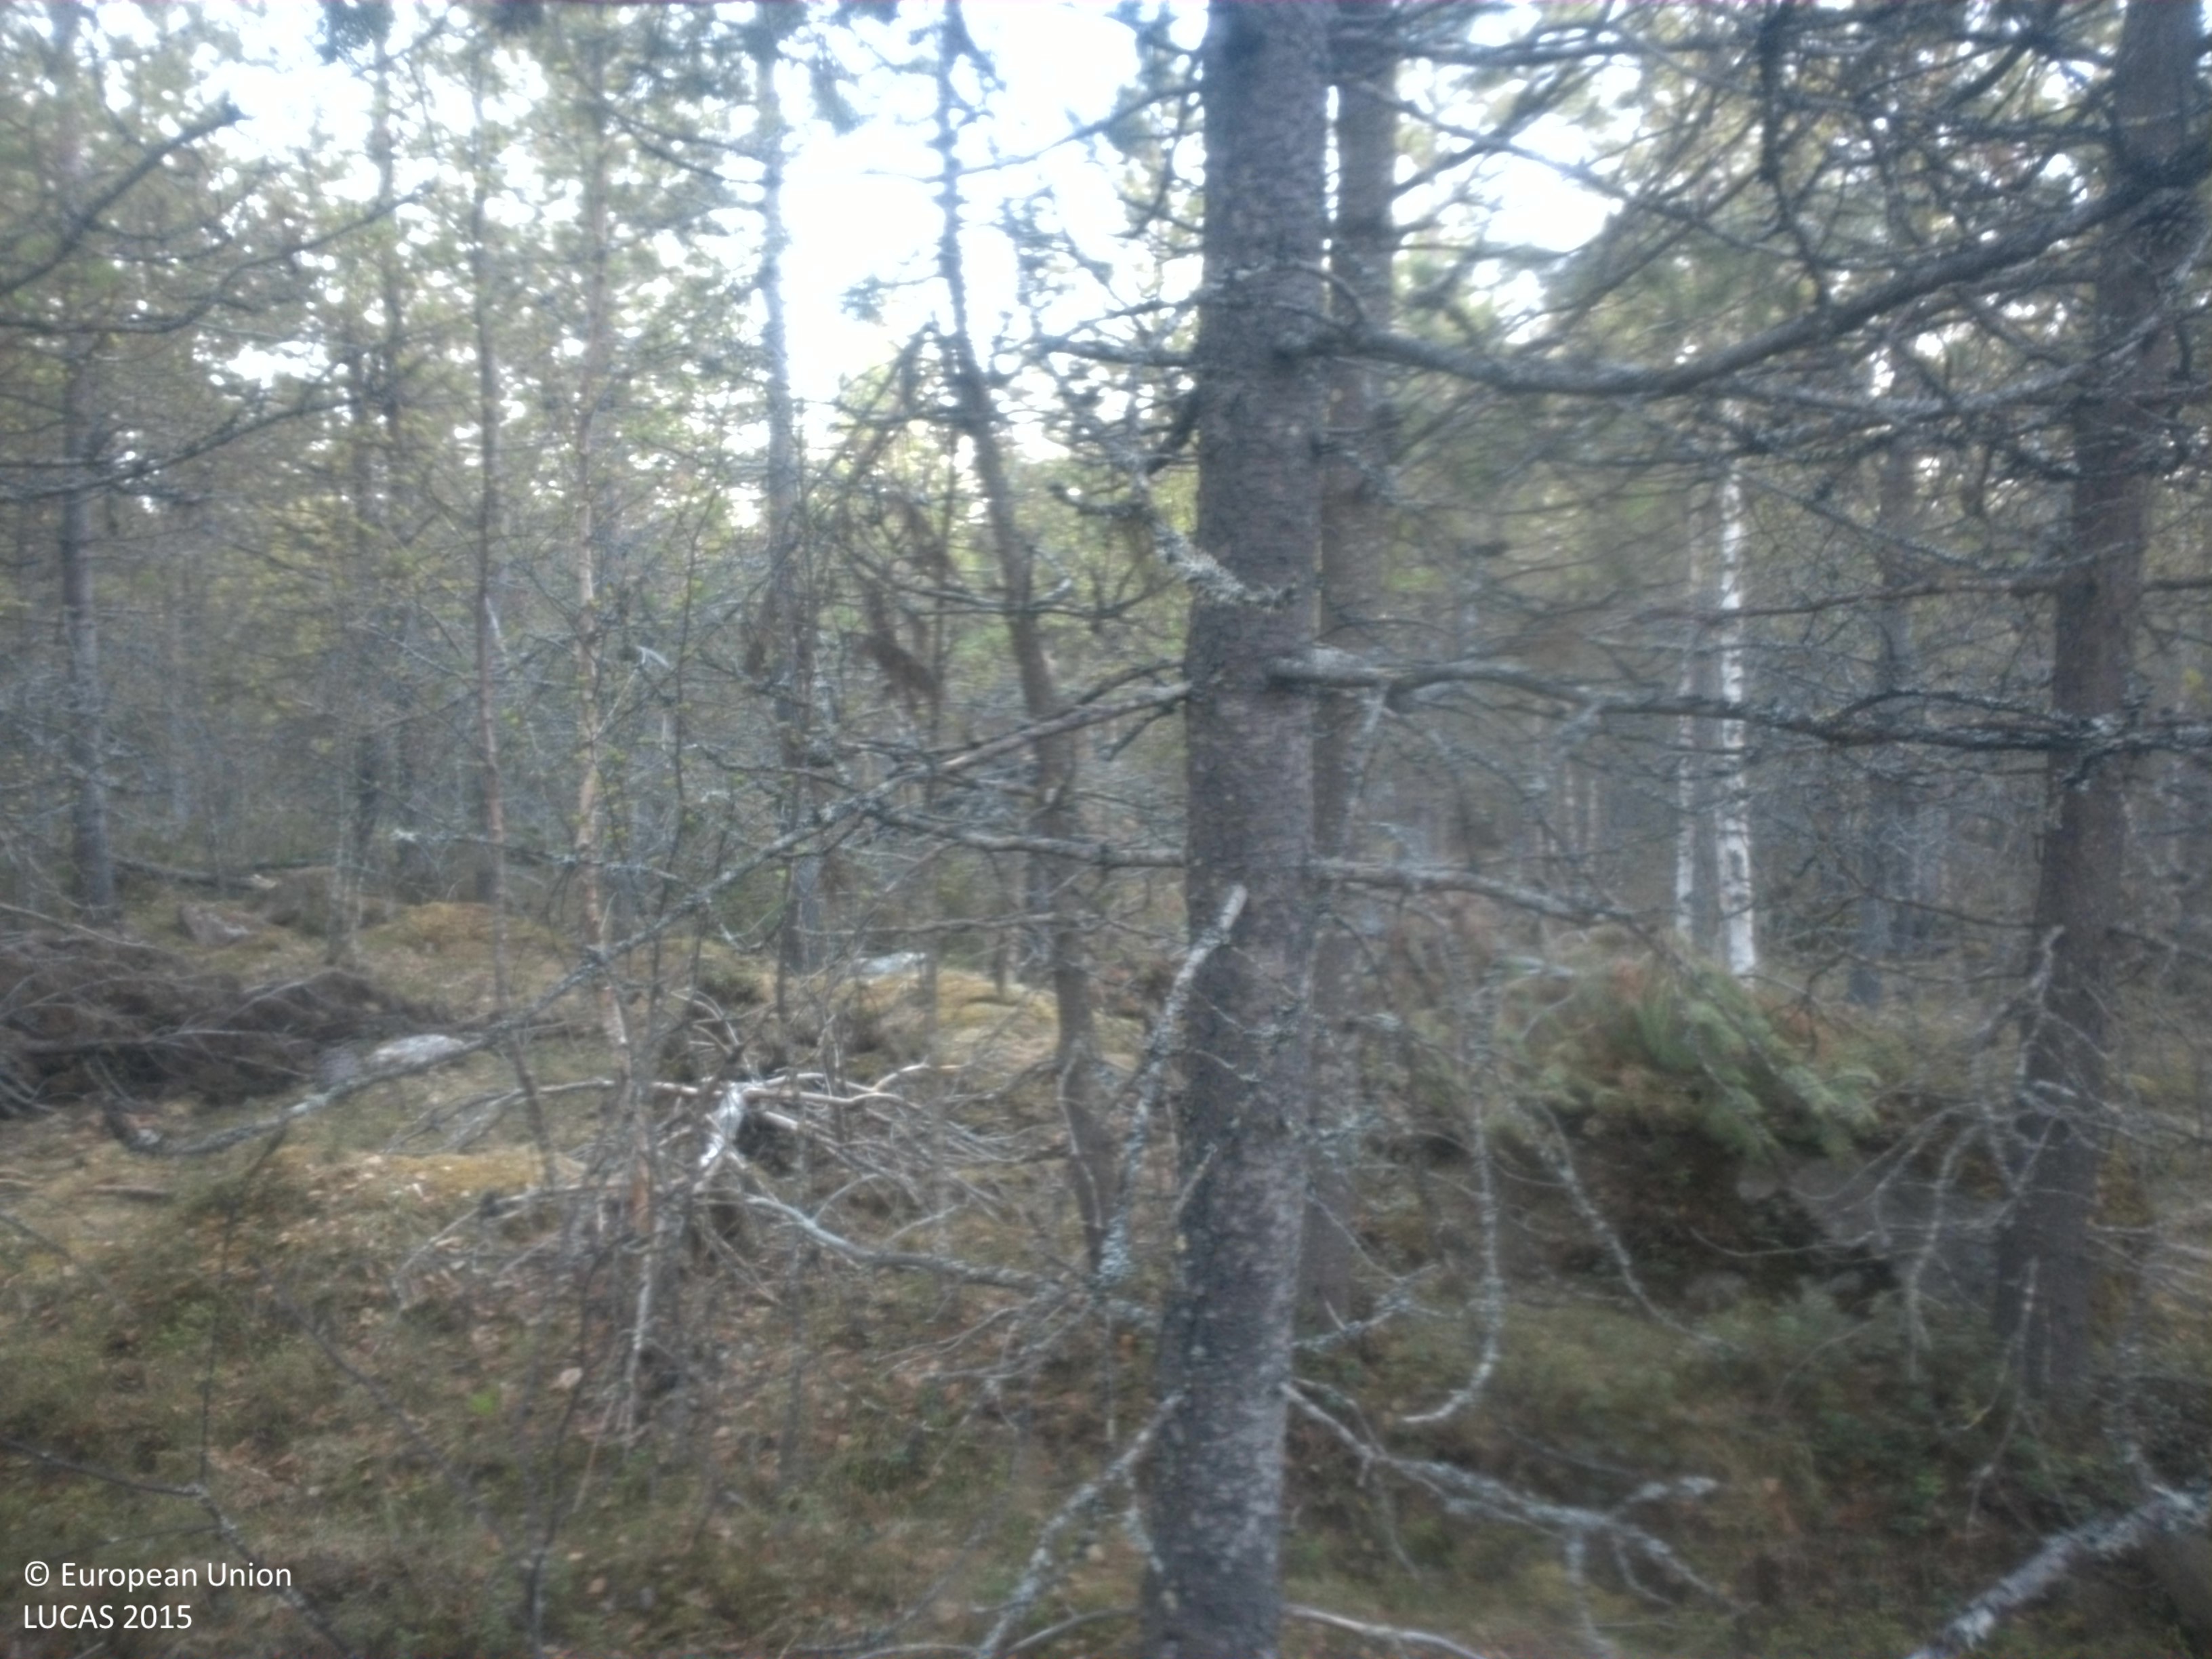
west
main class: Woodland
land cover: Pine dominated mixed woodland
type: exotic forest
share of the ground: 50 - 75 %
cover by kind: coniferous forest trees 45 %, herbaceous plants 20 %, broadleaved forest trees 15 %, lichens and mosses 10 %, shrubs 5 %, unconsolidated bare surface 5 %
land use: Forestry
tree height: > 5 m
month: June
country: SE
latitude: 64.4981
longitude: 17.7737
